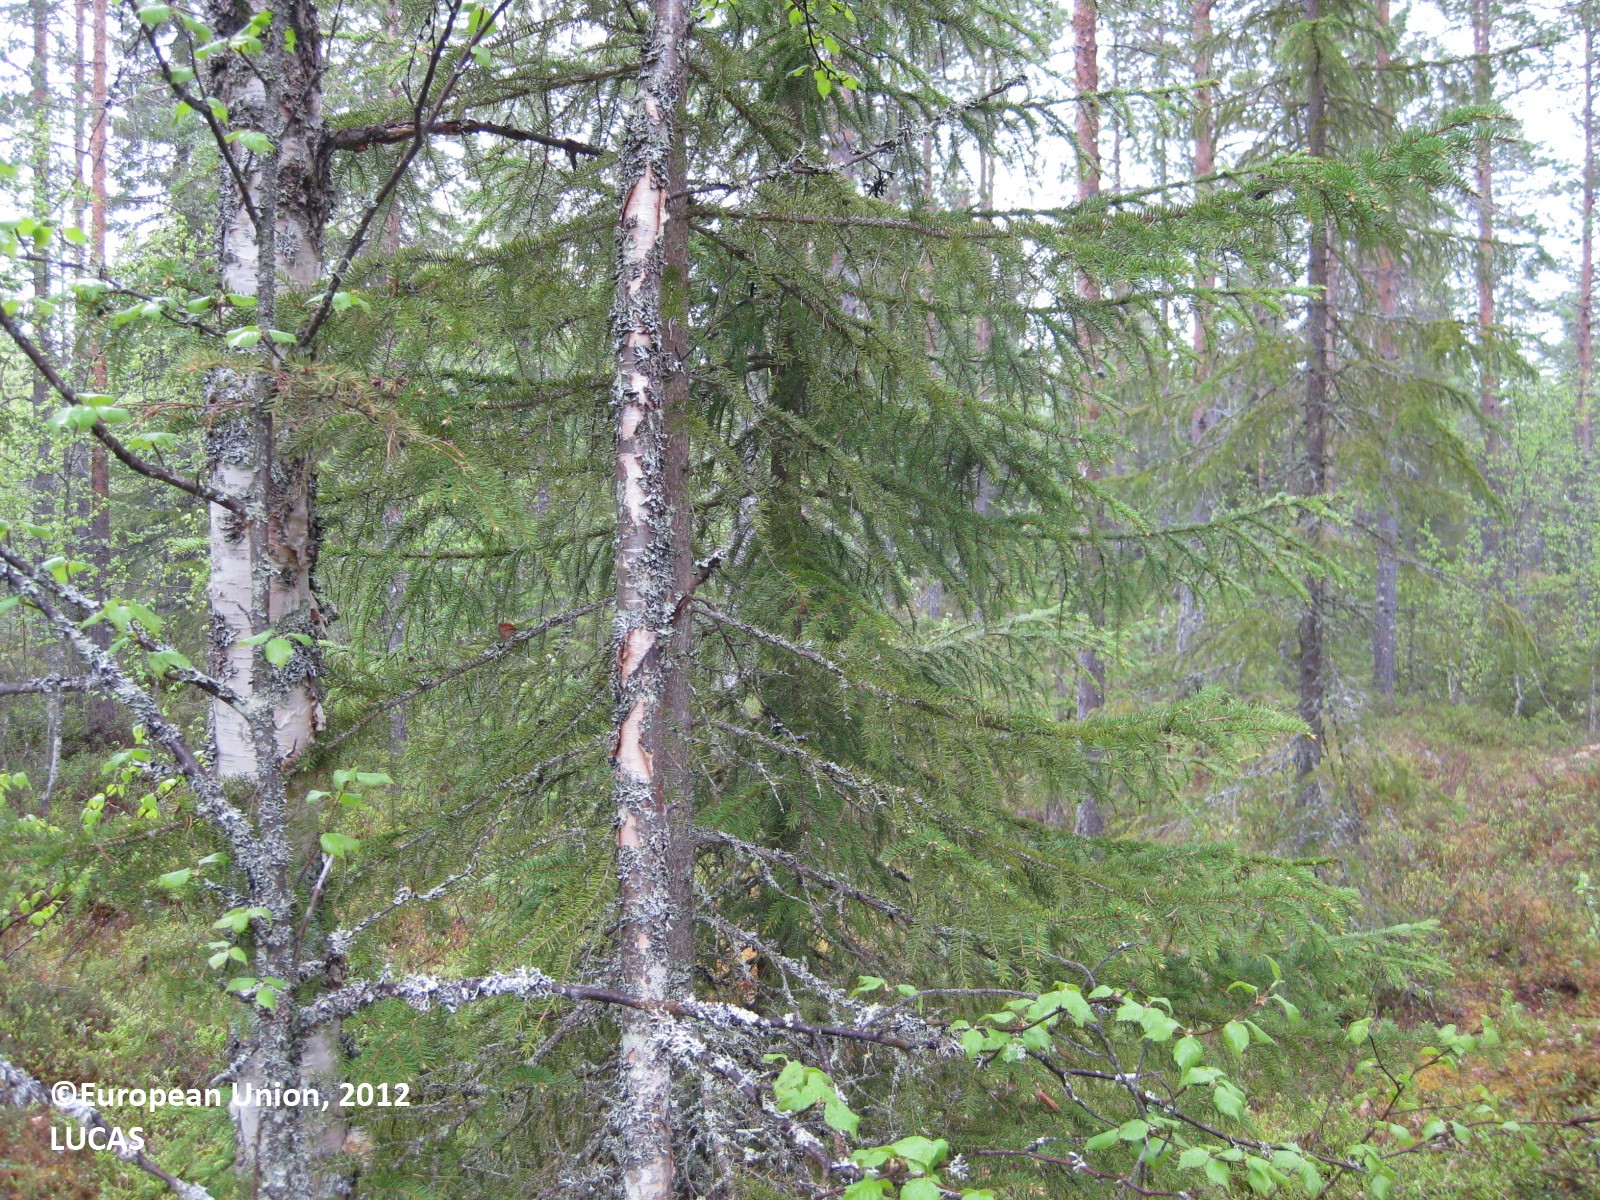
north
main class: Woodland
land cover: Other mixed woodland
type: boreal forest
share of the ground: > 75 %
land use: Forestry
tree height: > 5 m
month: June
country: FI
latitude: 65.2982
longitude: 29.2575
